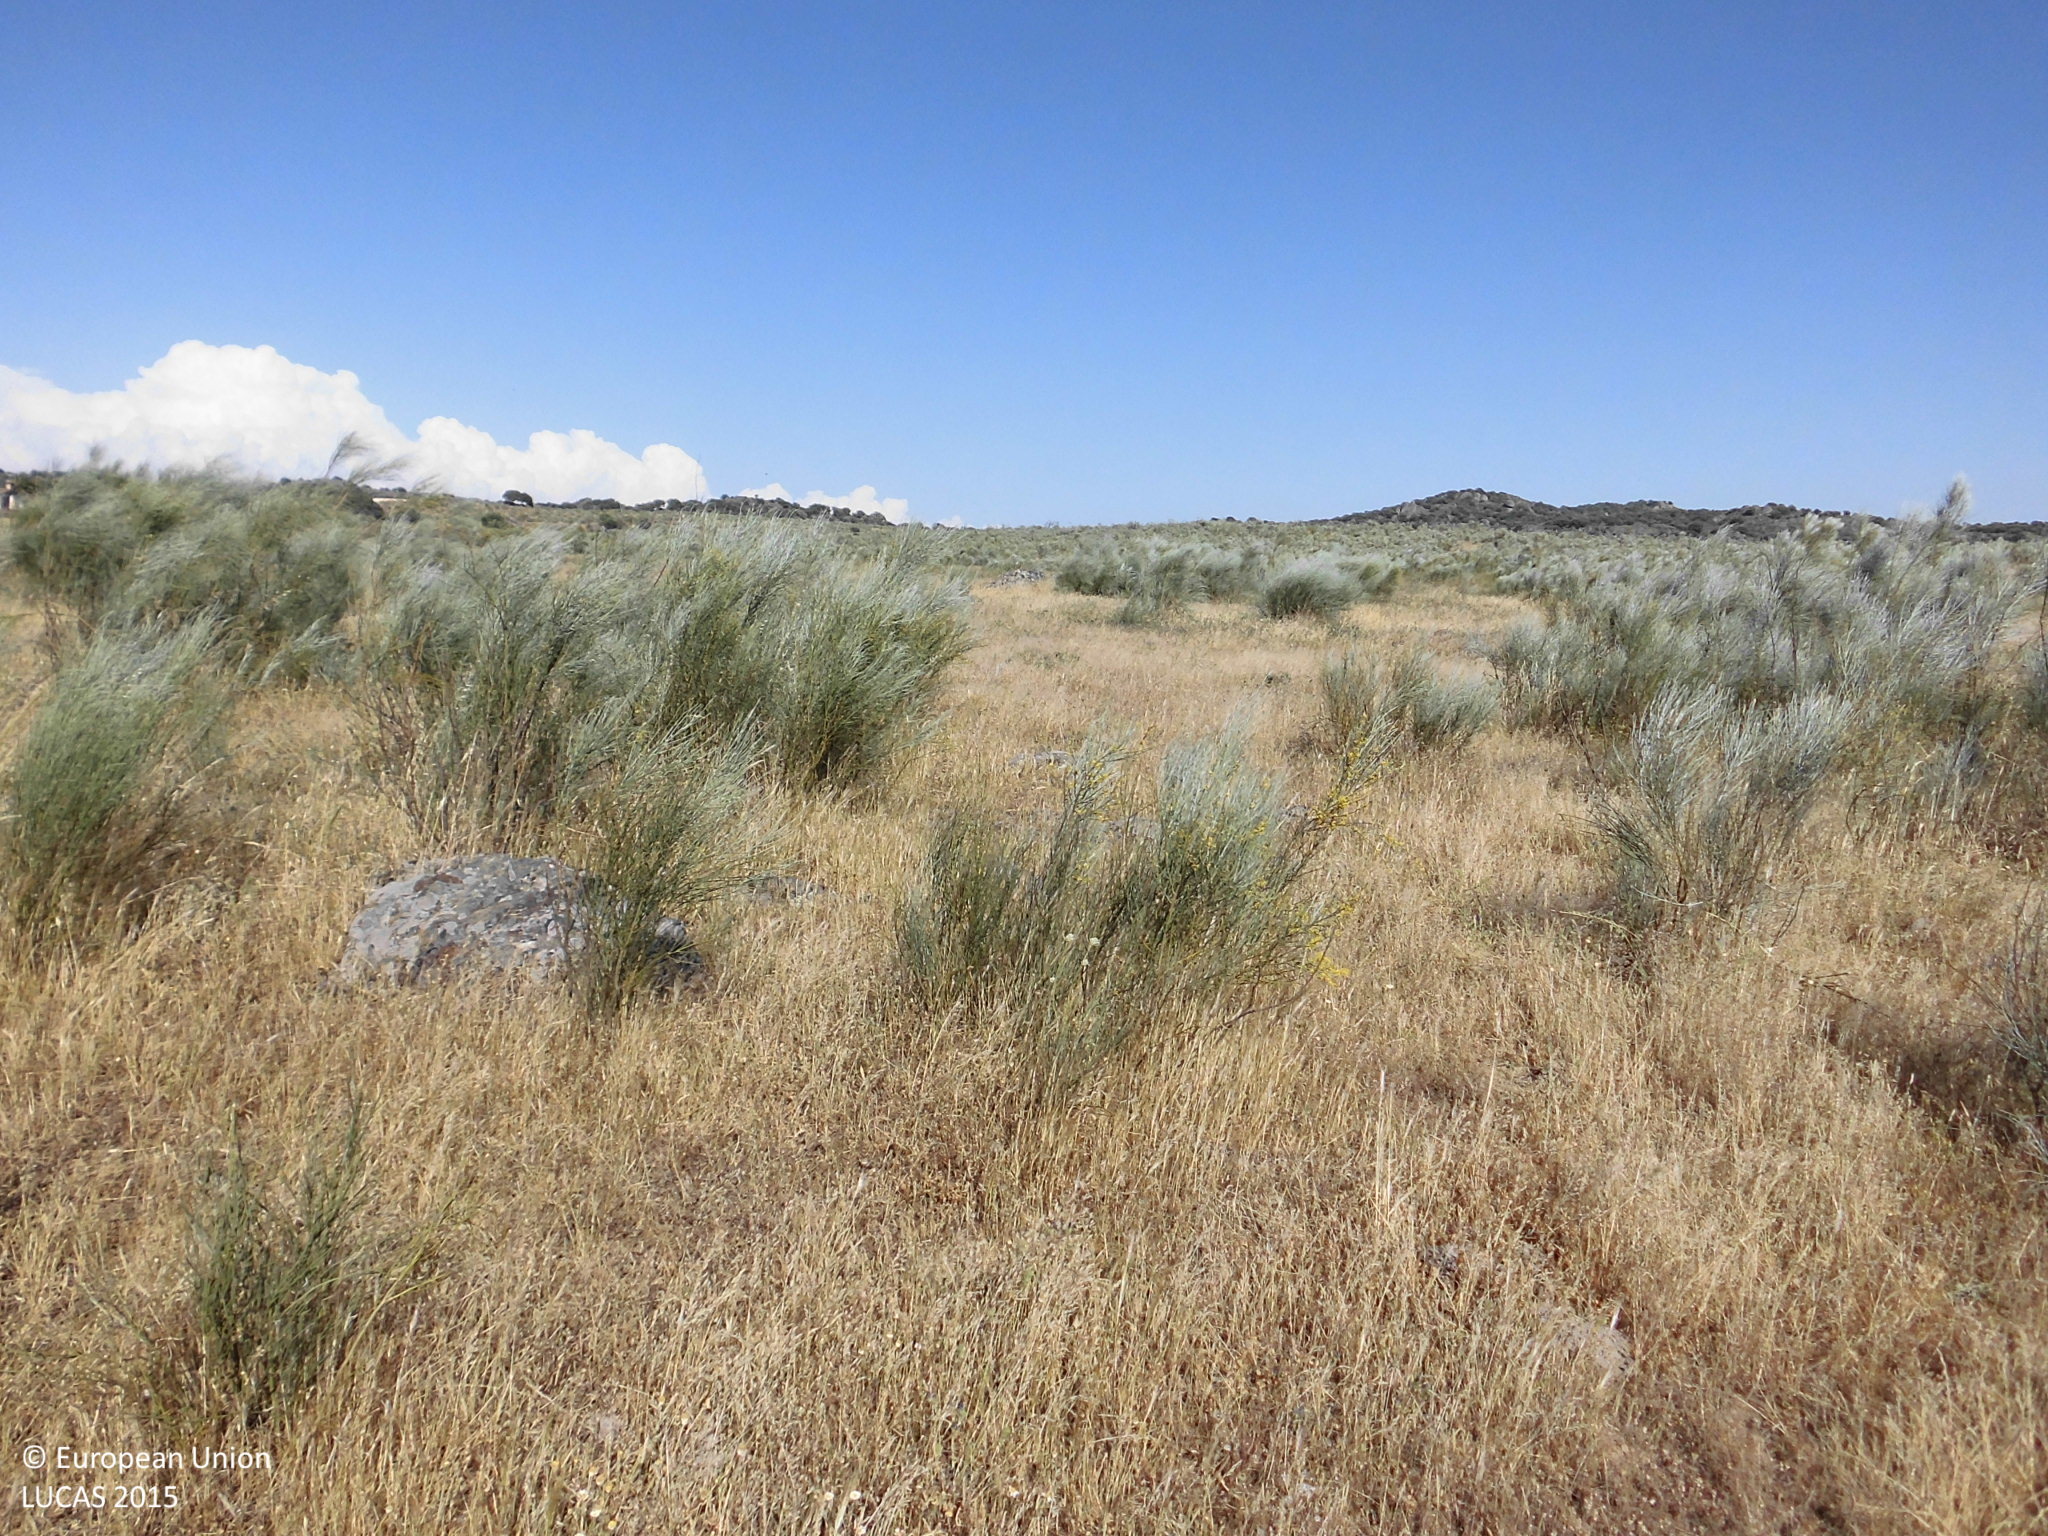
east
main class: Shrubland
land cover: Shrubland without tree cover
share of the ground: 10 - 25 %
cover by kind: herbaceous plants 85 %, shrubs 15 %
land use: Agriculture (excluding fallow land and kitchen gardens)
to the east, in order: Shrubland without tree cover; Tracks; Shrubland without tree cover
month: May
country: ES
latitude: 39.4103
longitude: -6.0768
